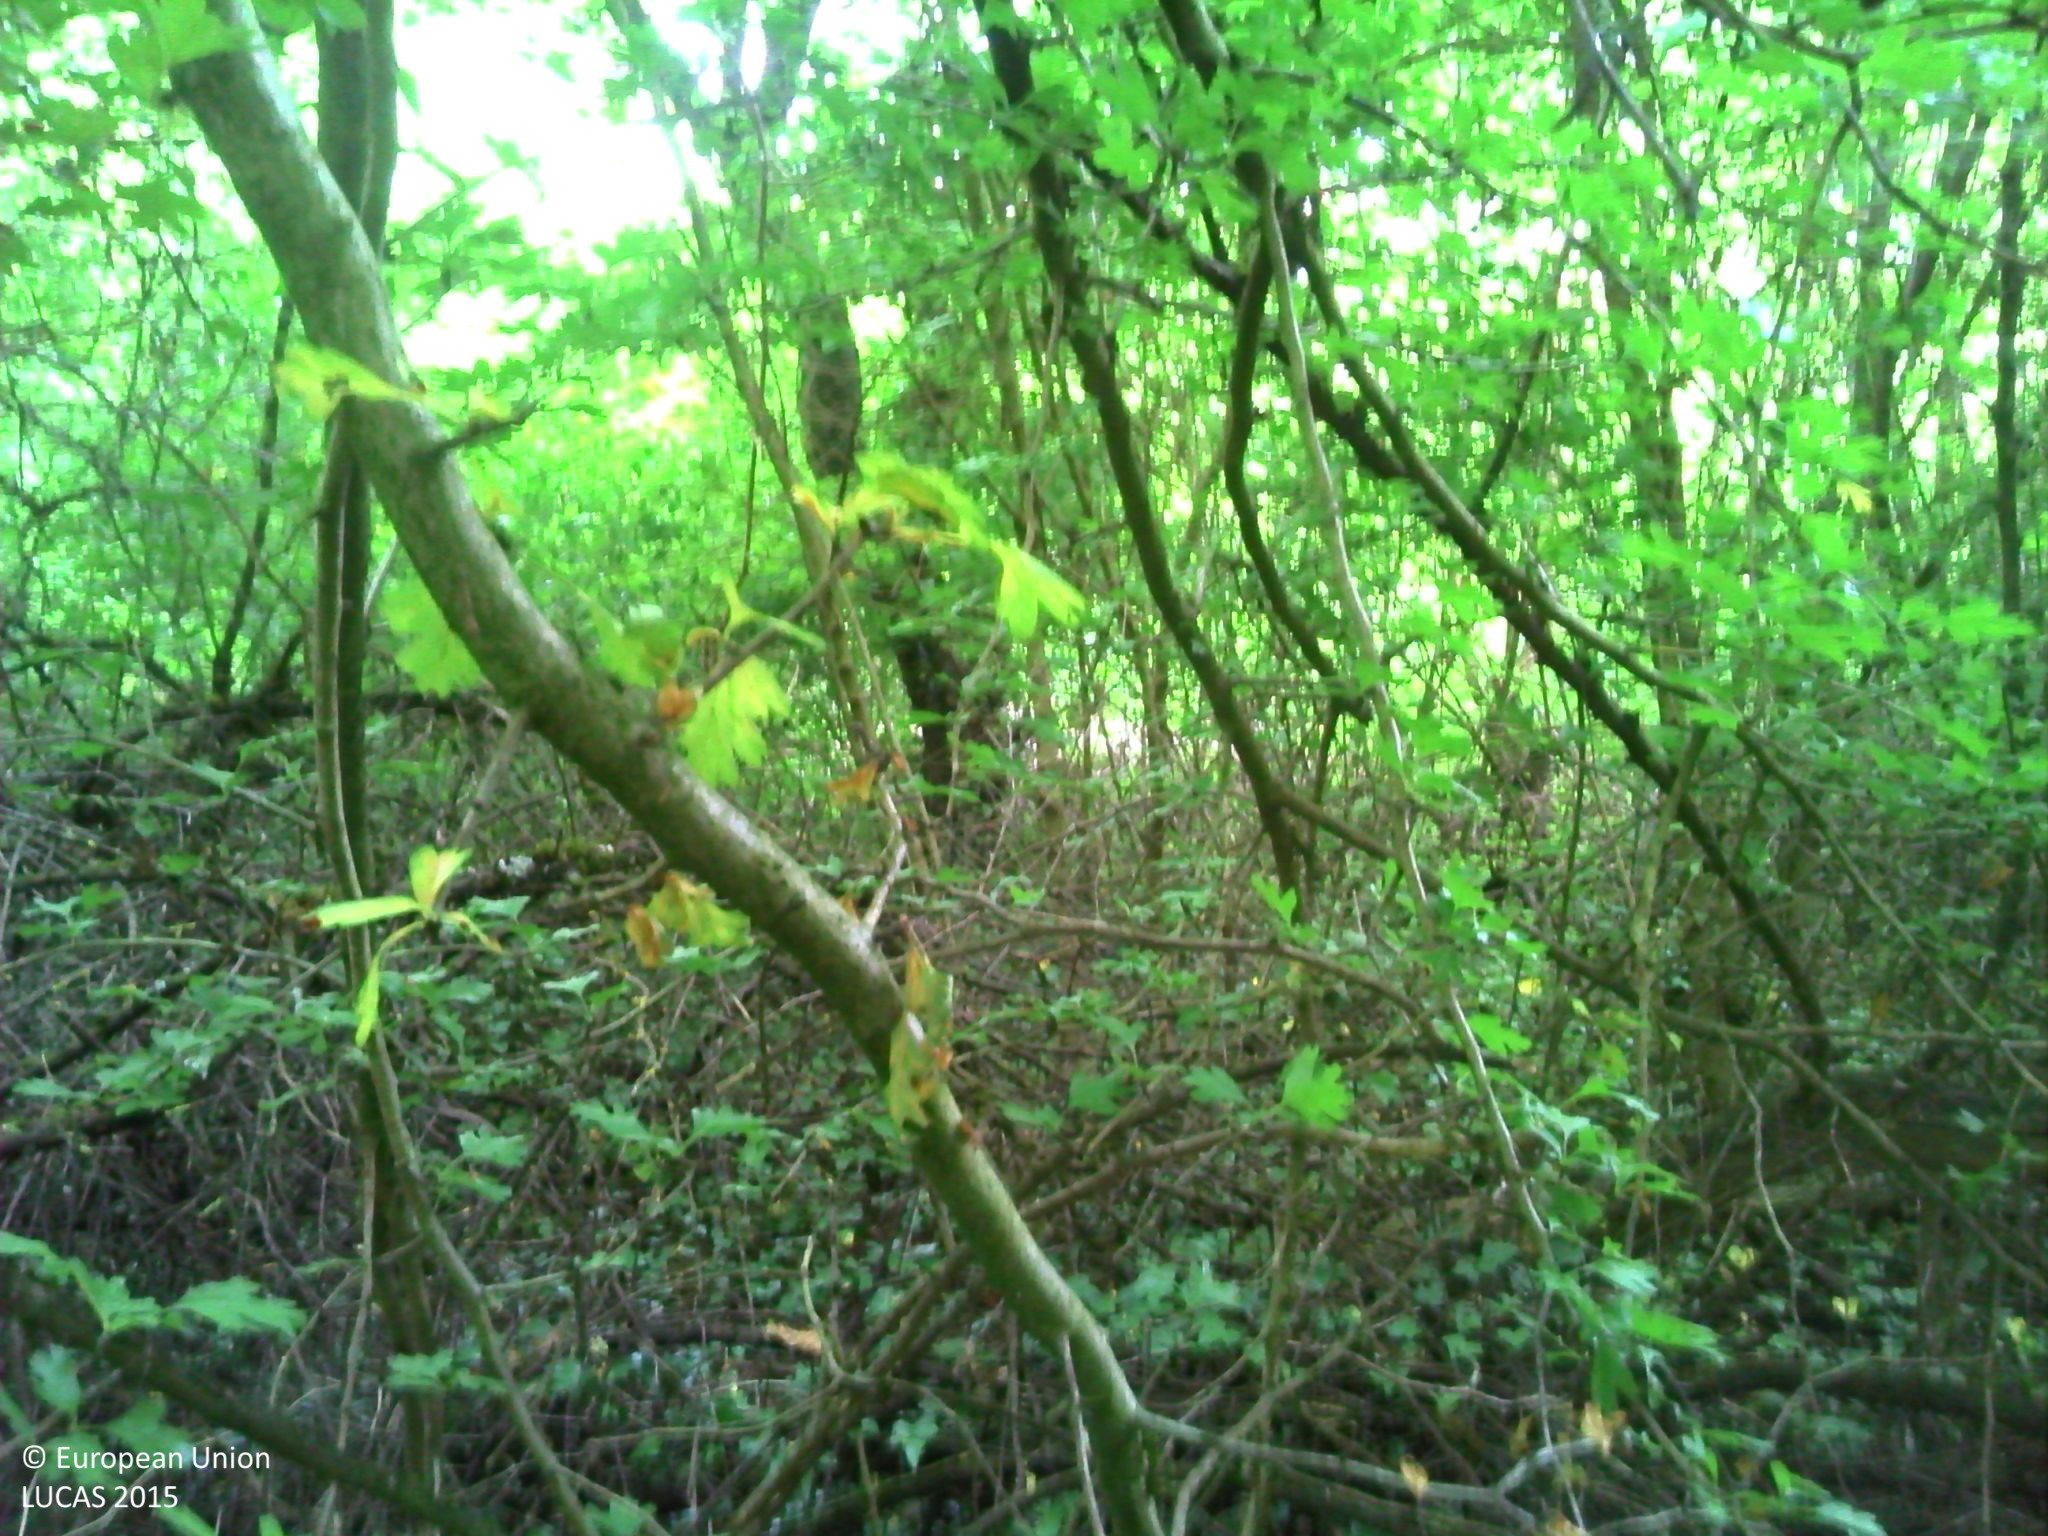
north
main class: Woodland
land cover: Broadleaved woodland
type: mesophytic deciduous forest
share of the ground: > 75 %
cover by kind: broadleaved forest trees 100 %
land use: Forestry
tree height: > 5 m
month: June
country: FR
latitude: 47.4903
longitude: 7.3870
